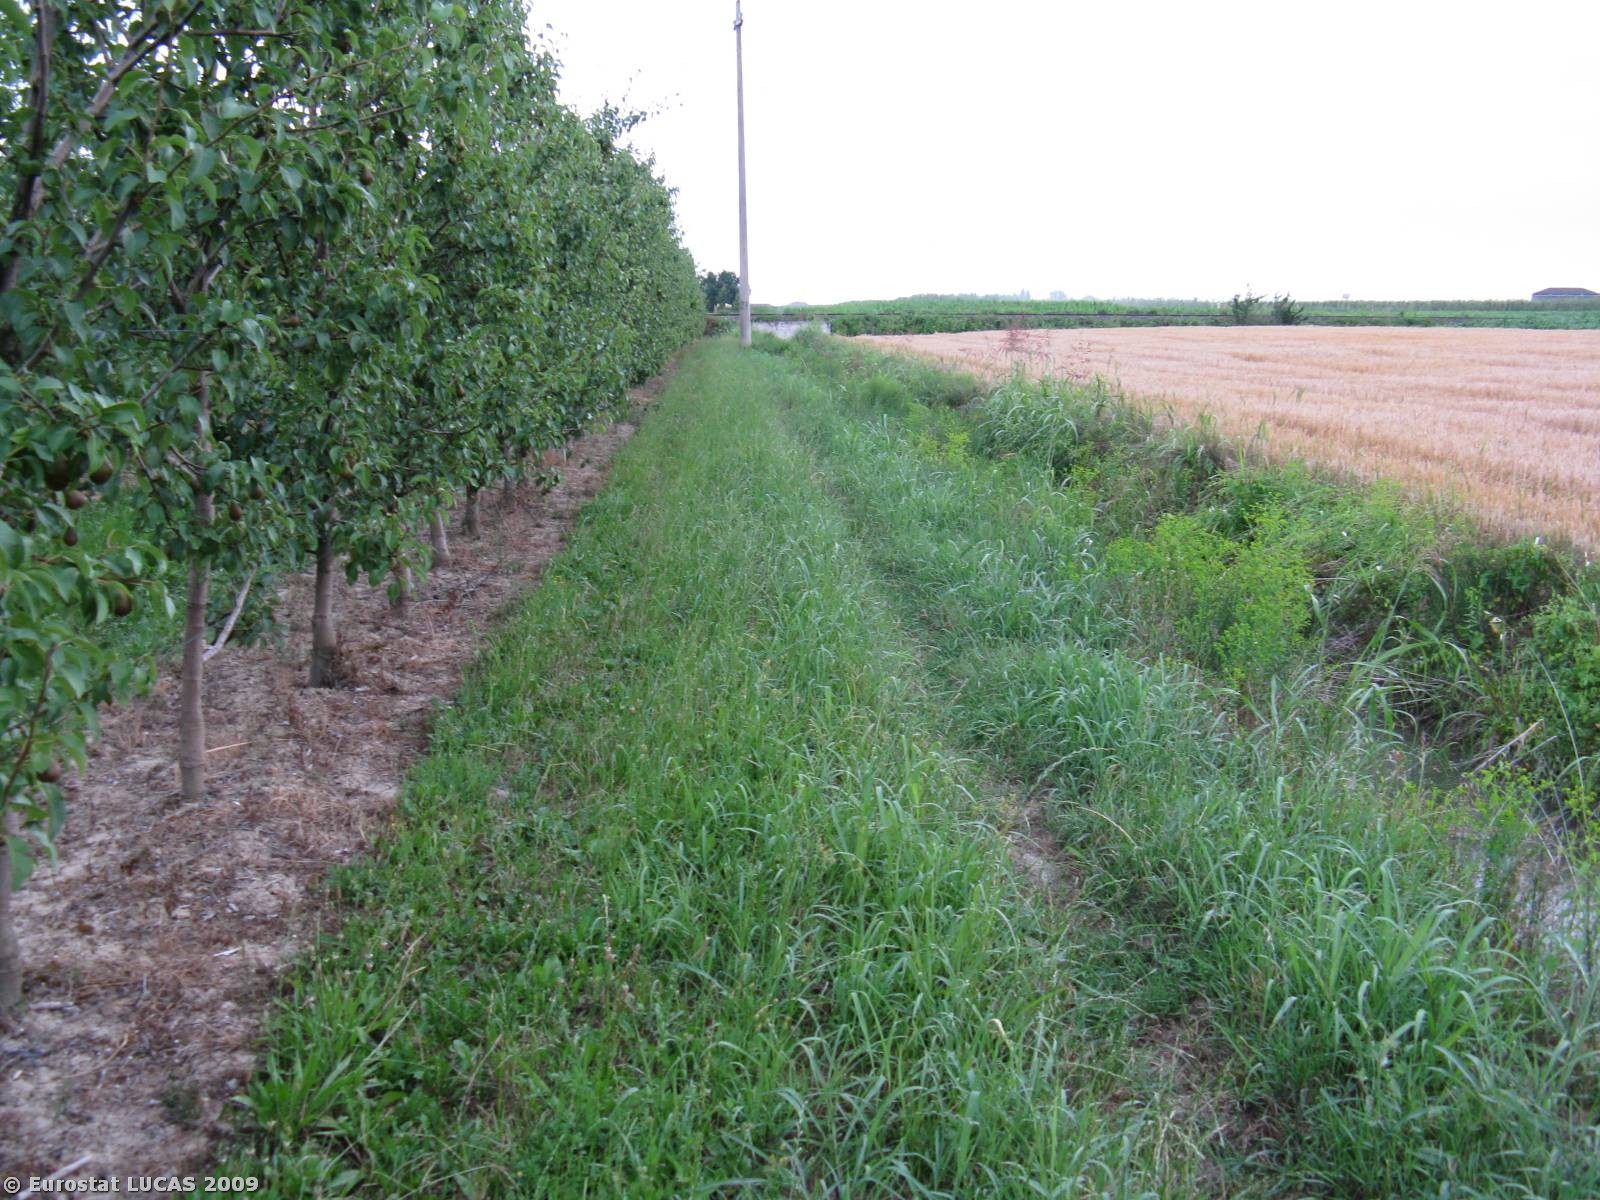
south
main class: Cropland
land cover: Pear fruit
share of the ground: 50 - 75 %
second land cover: Grassland with sparse tree/shrub cover
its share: 50 - 75 %
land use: Agriculture (excluding fallow land and kitchen gardens)
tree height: < 5 m
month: June
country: IT
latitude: 44.8051
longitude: 11.7287
